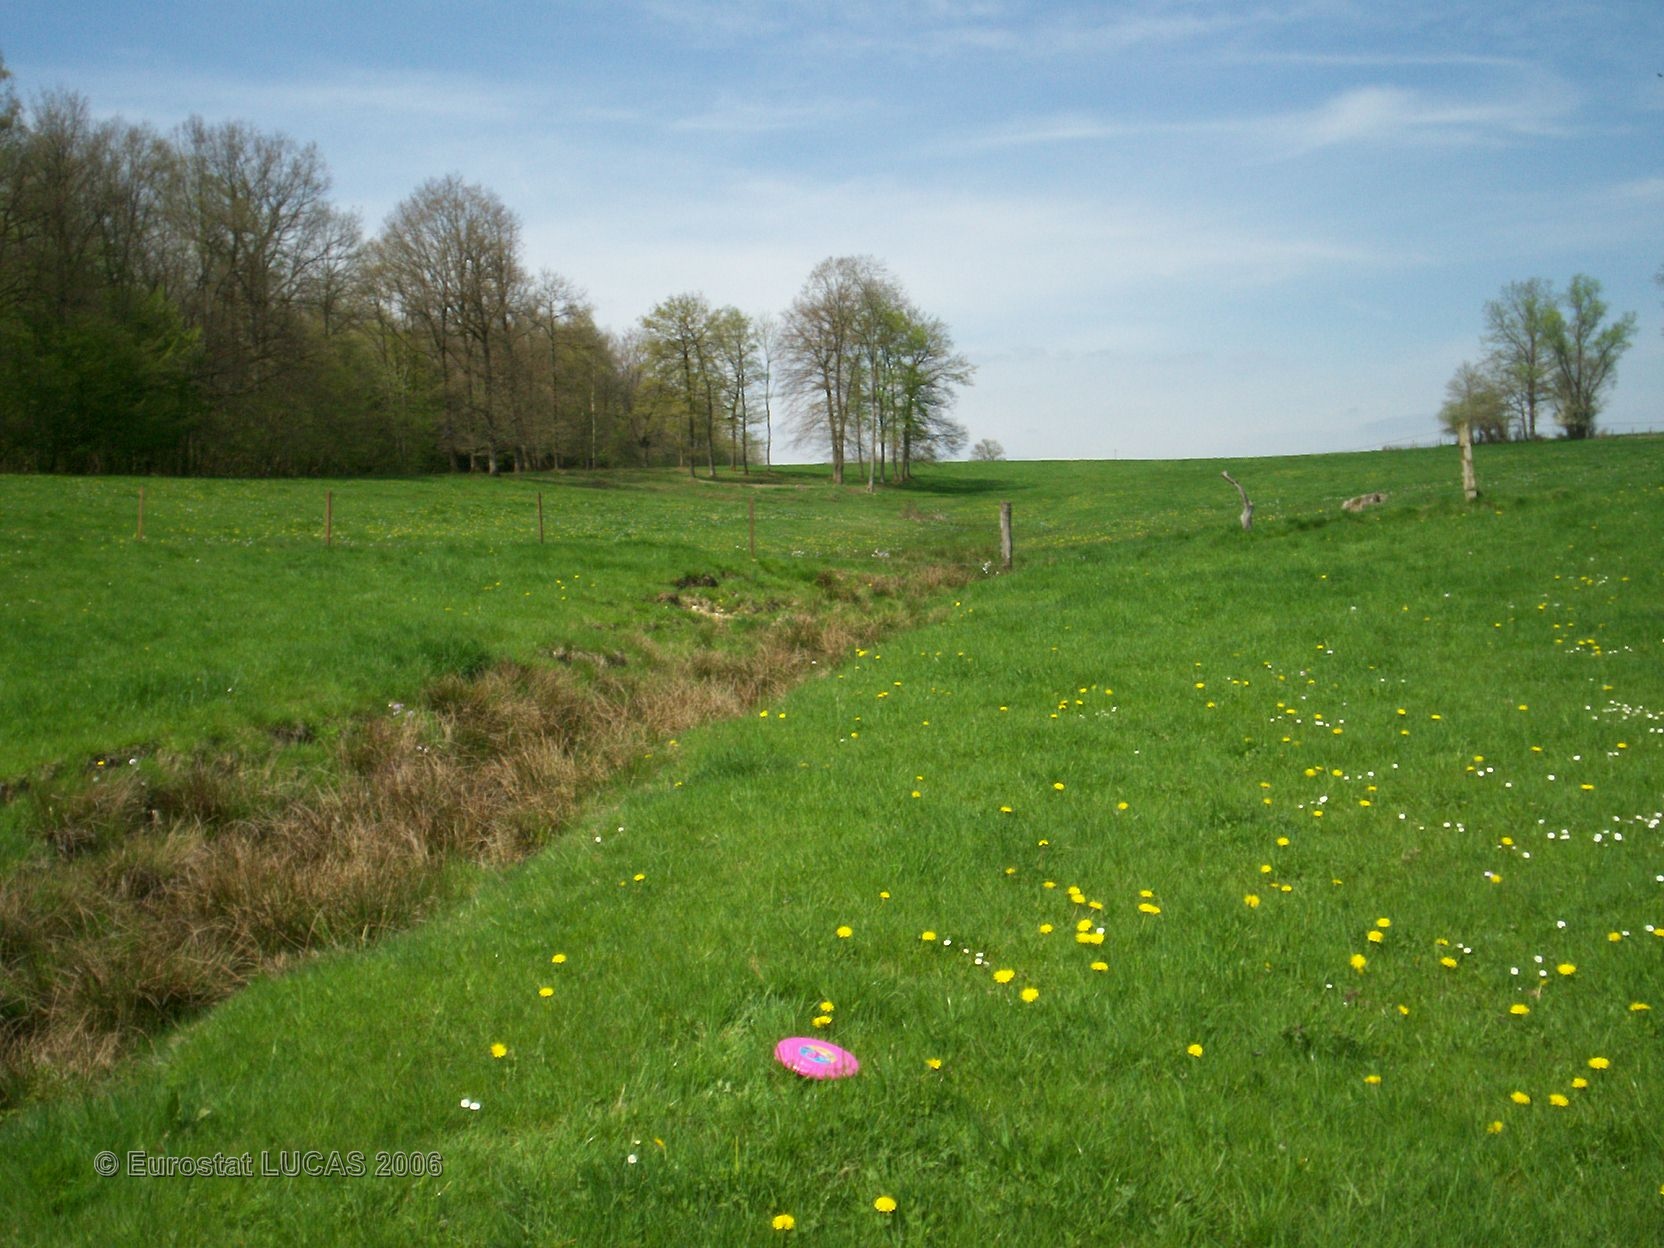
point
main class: Grassland
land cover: Grassland without tree/shrub cover
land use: Agriculture (excluding fallow land and kitchen gardens)
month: April
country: FR
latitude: 49.7183
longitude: 4.3228
